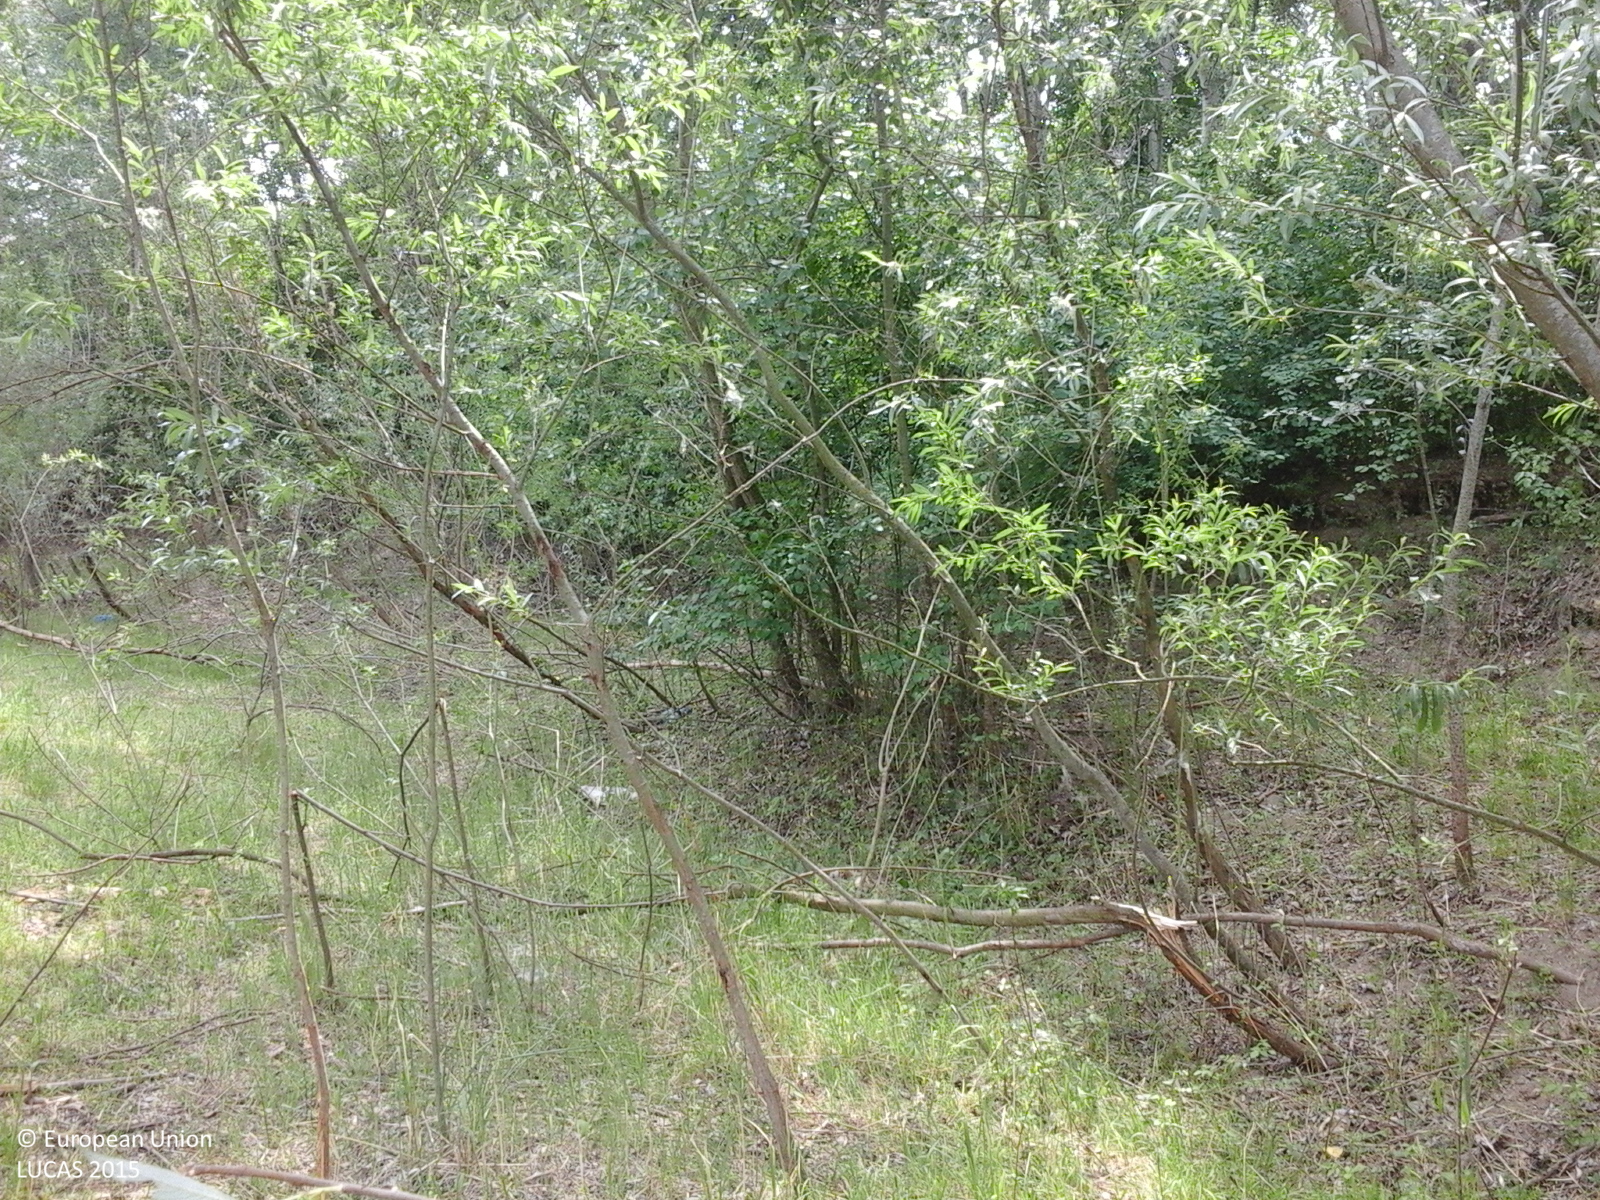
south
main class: Woodland
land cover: Broadleaved woodland
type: floodplain forest
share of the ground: > 75 %
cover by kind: broadleaved forest trees 85 %, shrubs 10 %, herbaceous plants 5 %
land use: Semi-natural and natural areas not in use
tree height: < 5 m
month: June
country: RO
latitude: 47.0413
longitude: 26.7415
